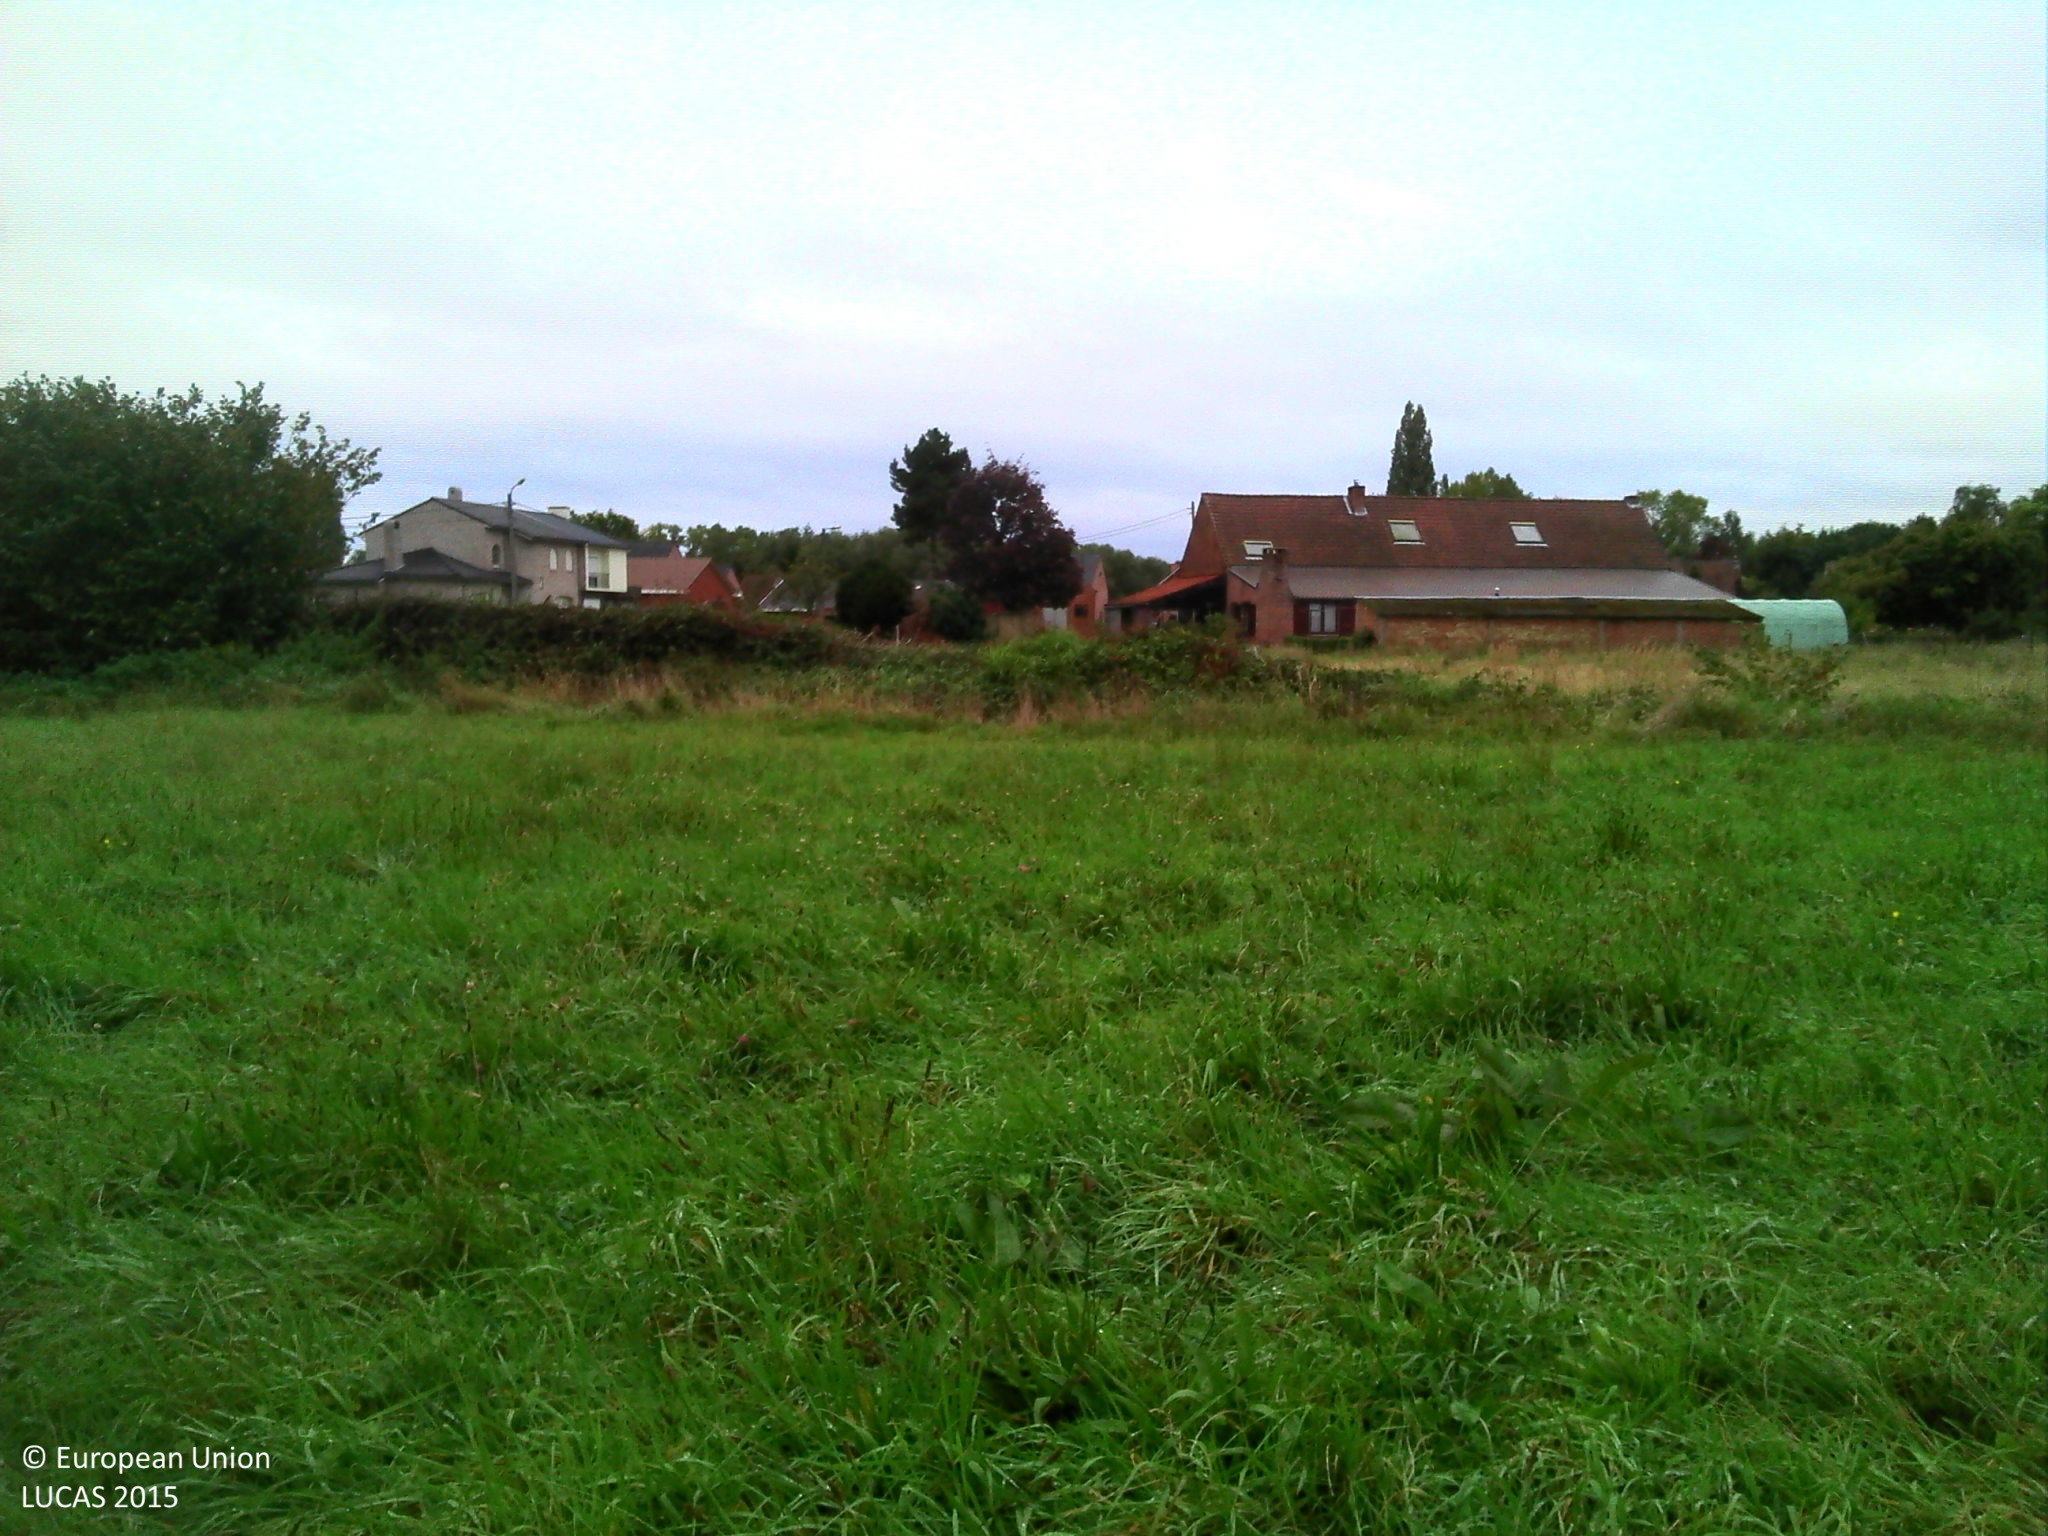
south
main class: Grassland
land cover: Grassland without tree/shrub cover
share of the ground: > 75 %
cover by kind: herbaceous plants 100 %
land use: Agriculture (excluding fallow land and kitchen gardens)
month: October
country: BE
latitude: 51.0549
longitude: 4.7606
